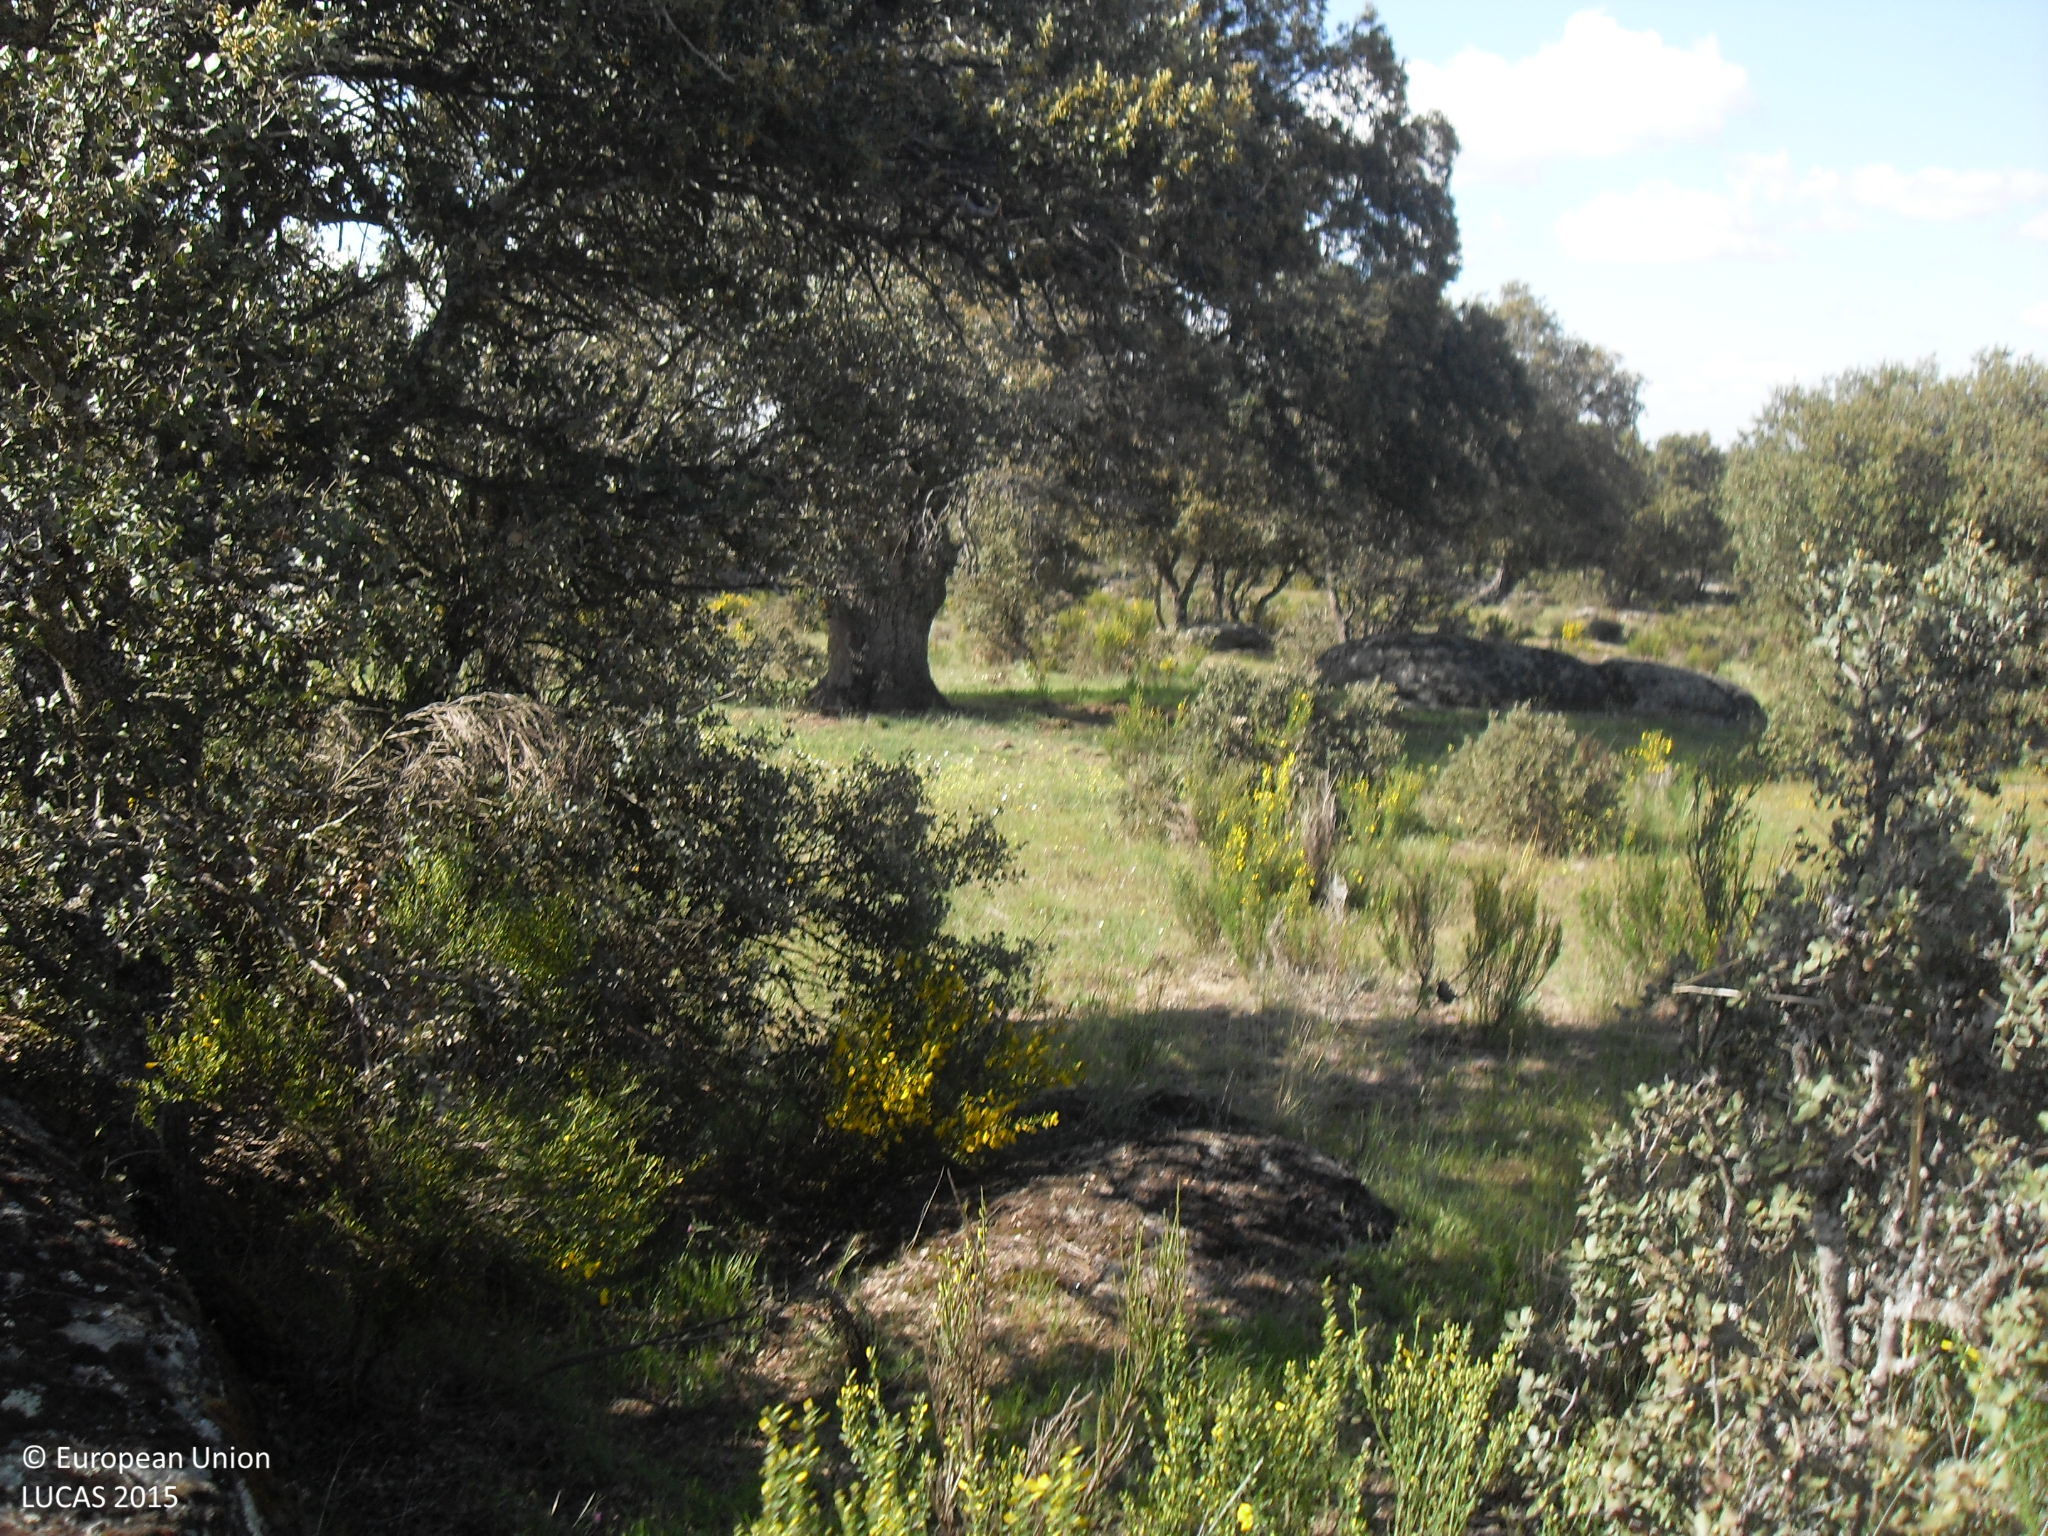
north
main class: Woodland
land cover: Broadleaved woodland
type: broadleaved evergreen forest
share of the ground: 10 - 25 %
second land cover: Grassland without tree/shrub cover
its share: > 75 %
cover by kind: herbaceous plants 85 %, broadleaved forest trees 15 %
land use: Forestry
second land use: Agriculture (excluding fallow land and kitchen gardens)
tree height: < 5 m
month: May
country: ES
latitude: 40.6808
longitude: -5.2693
